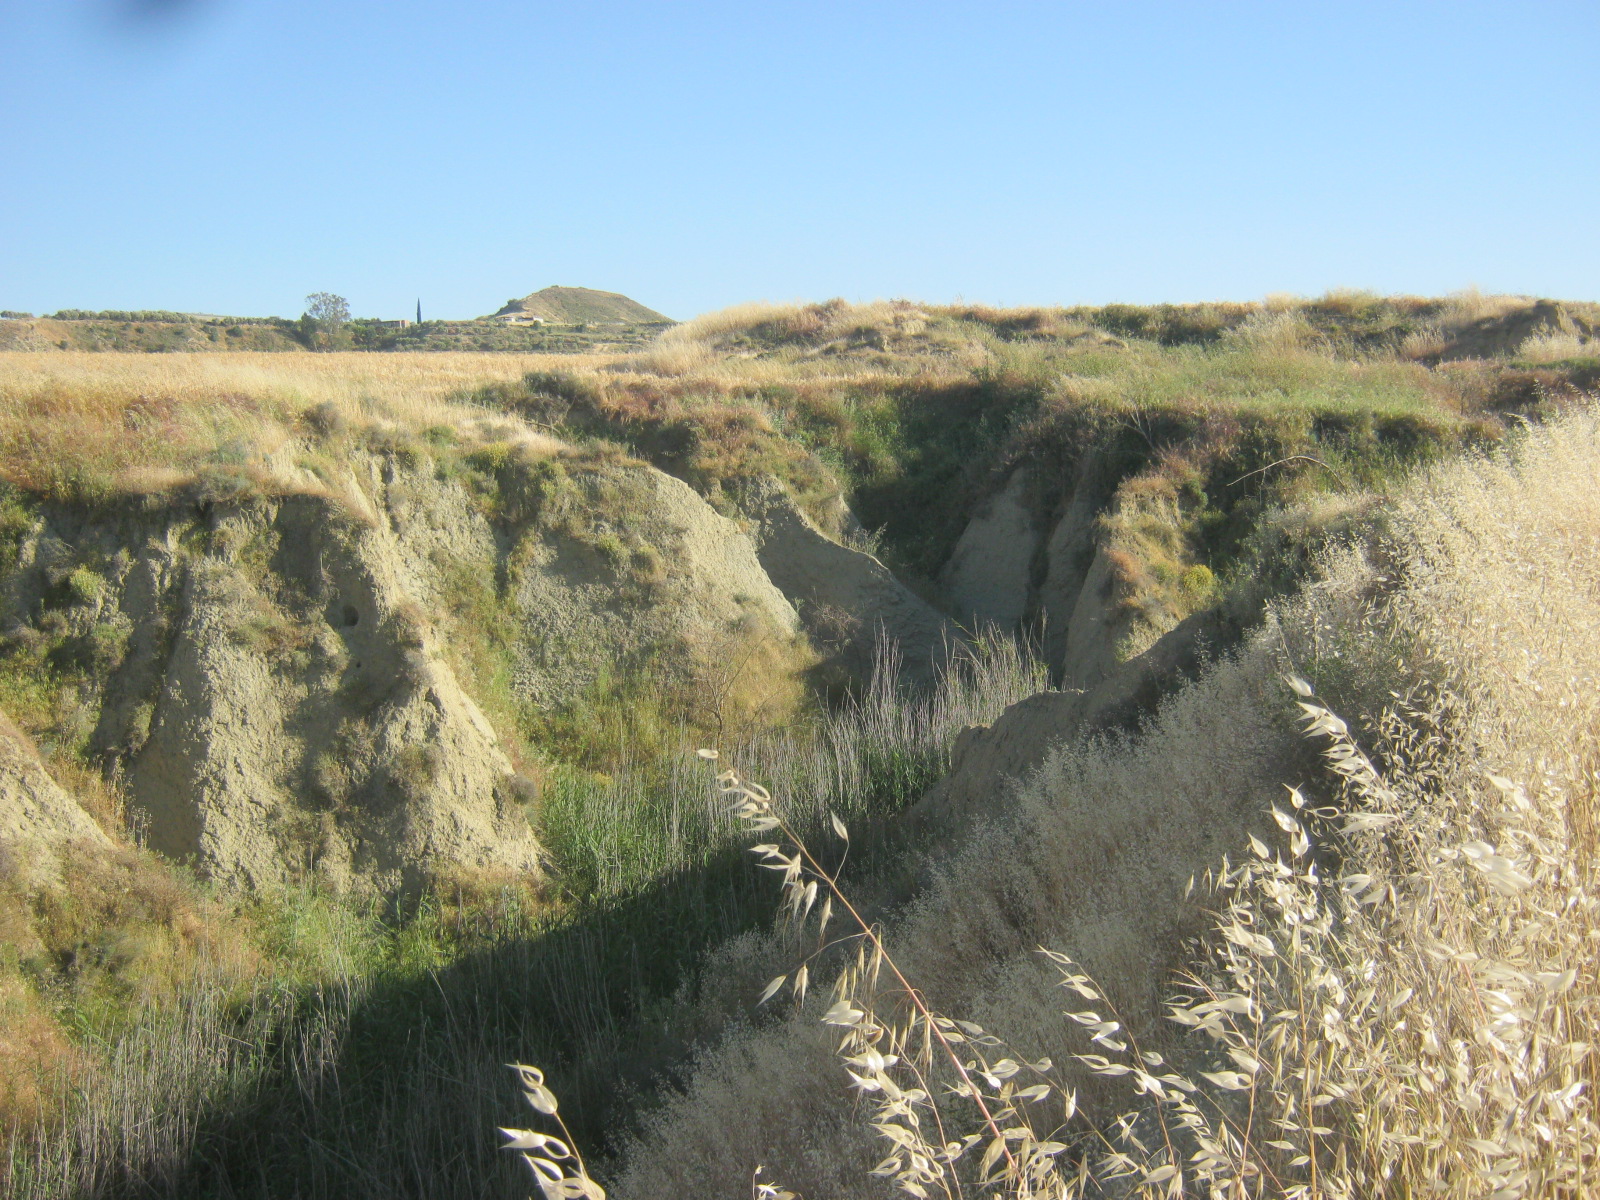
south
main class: Grassland
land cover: Spontaneously vegetated surfaces
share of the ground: > 75 %
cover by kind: herbaceous plants 95 %, unconsolidated bare surface 5 %
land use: Semi-natural and natural areas not in use
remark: Temporary dry
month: May
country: CY
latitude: 35.0563
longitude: 33.2204
